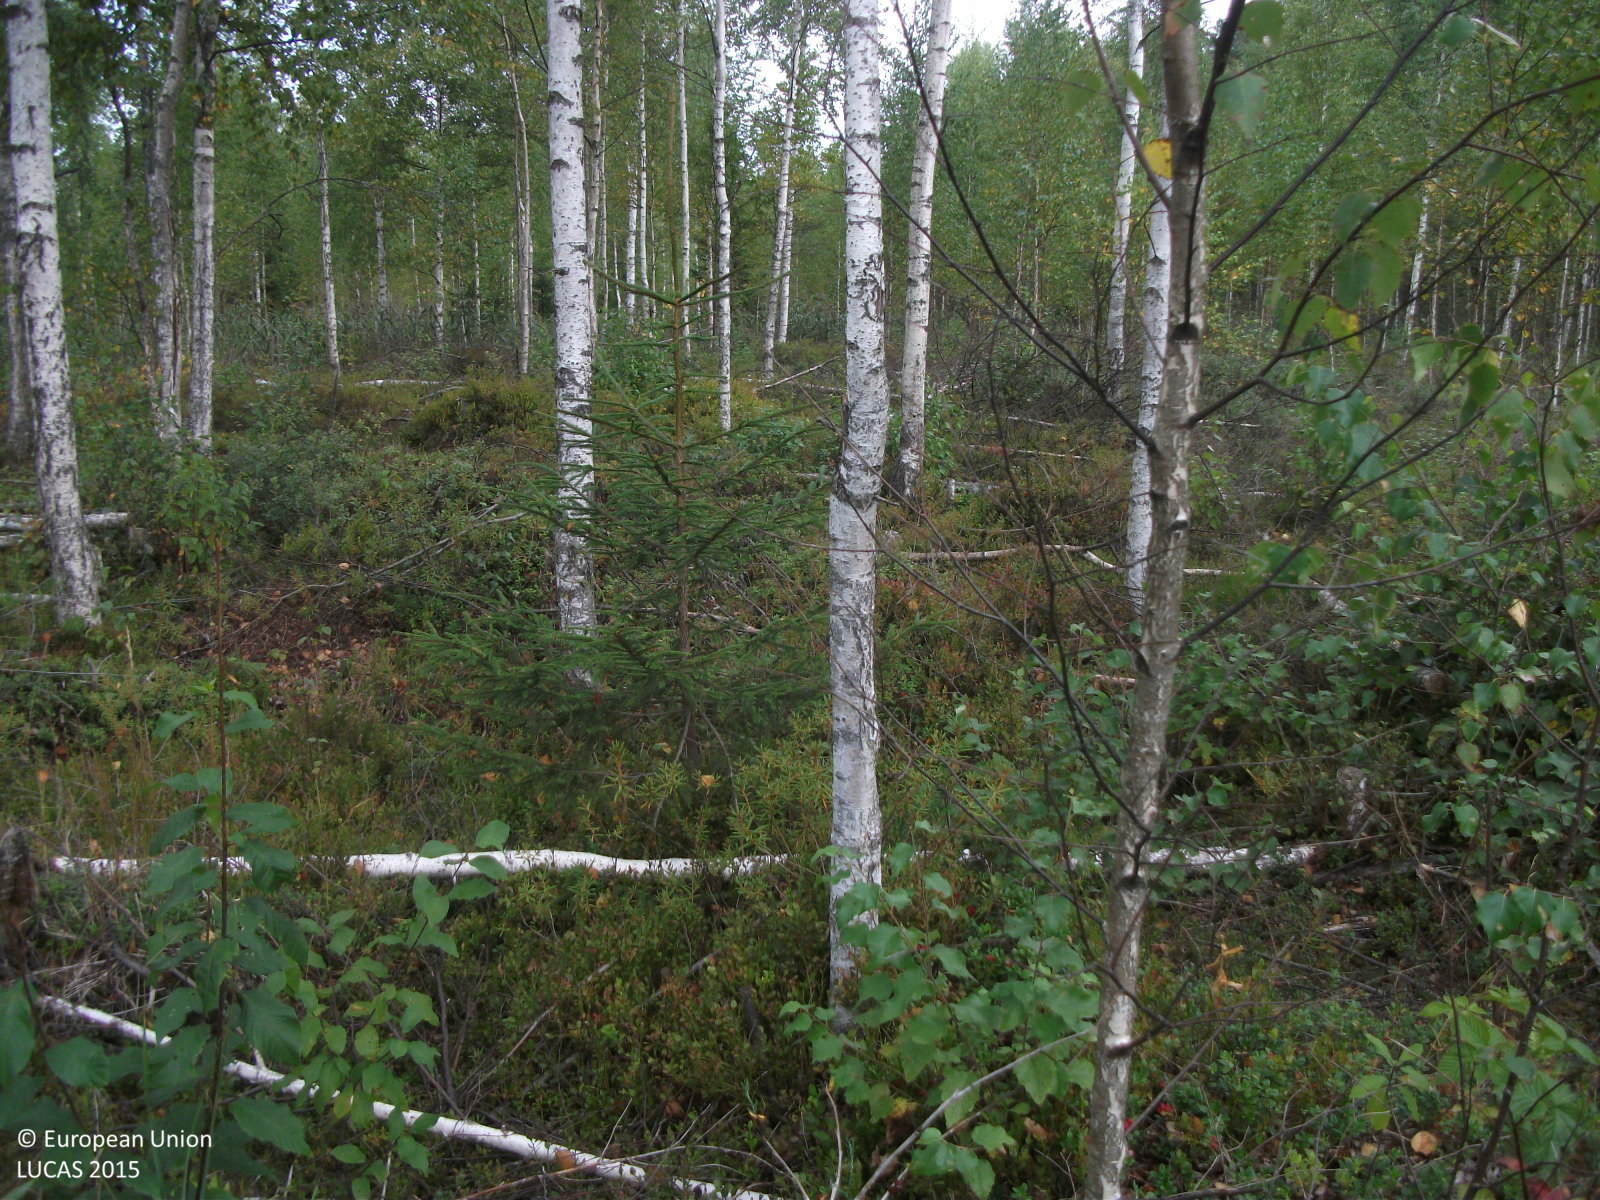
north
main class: Woodland
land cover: Broadleaved woodland
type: non-riverine alder, birch or aspen forest
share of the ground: 50 - 75 %
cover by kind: broadleaved forest trees 60 %, shrubs 20 %, herbaceous plants 10 %, lichens and mosses 10 %
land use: Forestry
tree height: < 5 m
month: September
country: LV
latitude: 56.5639
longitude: 26.2001
